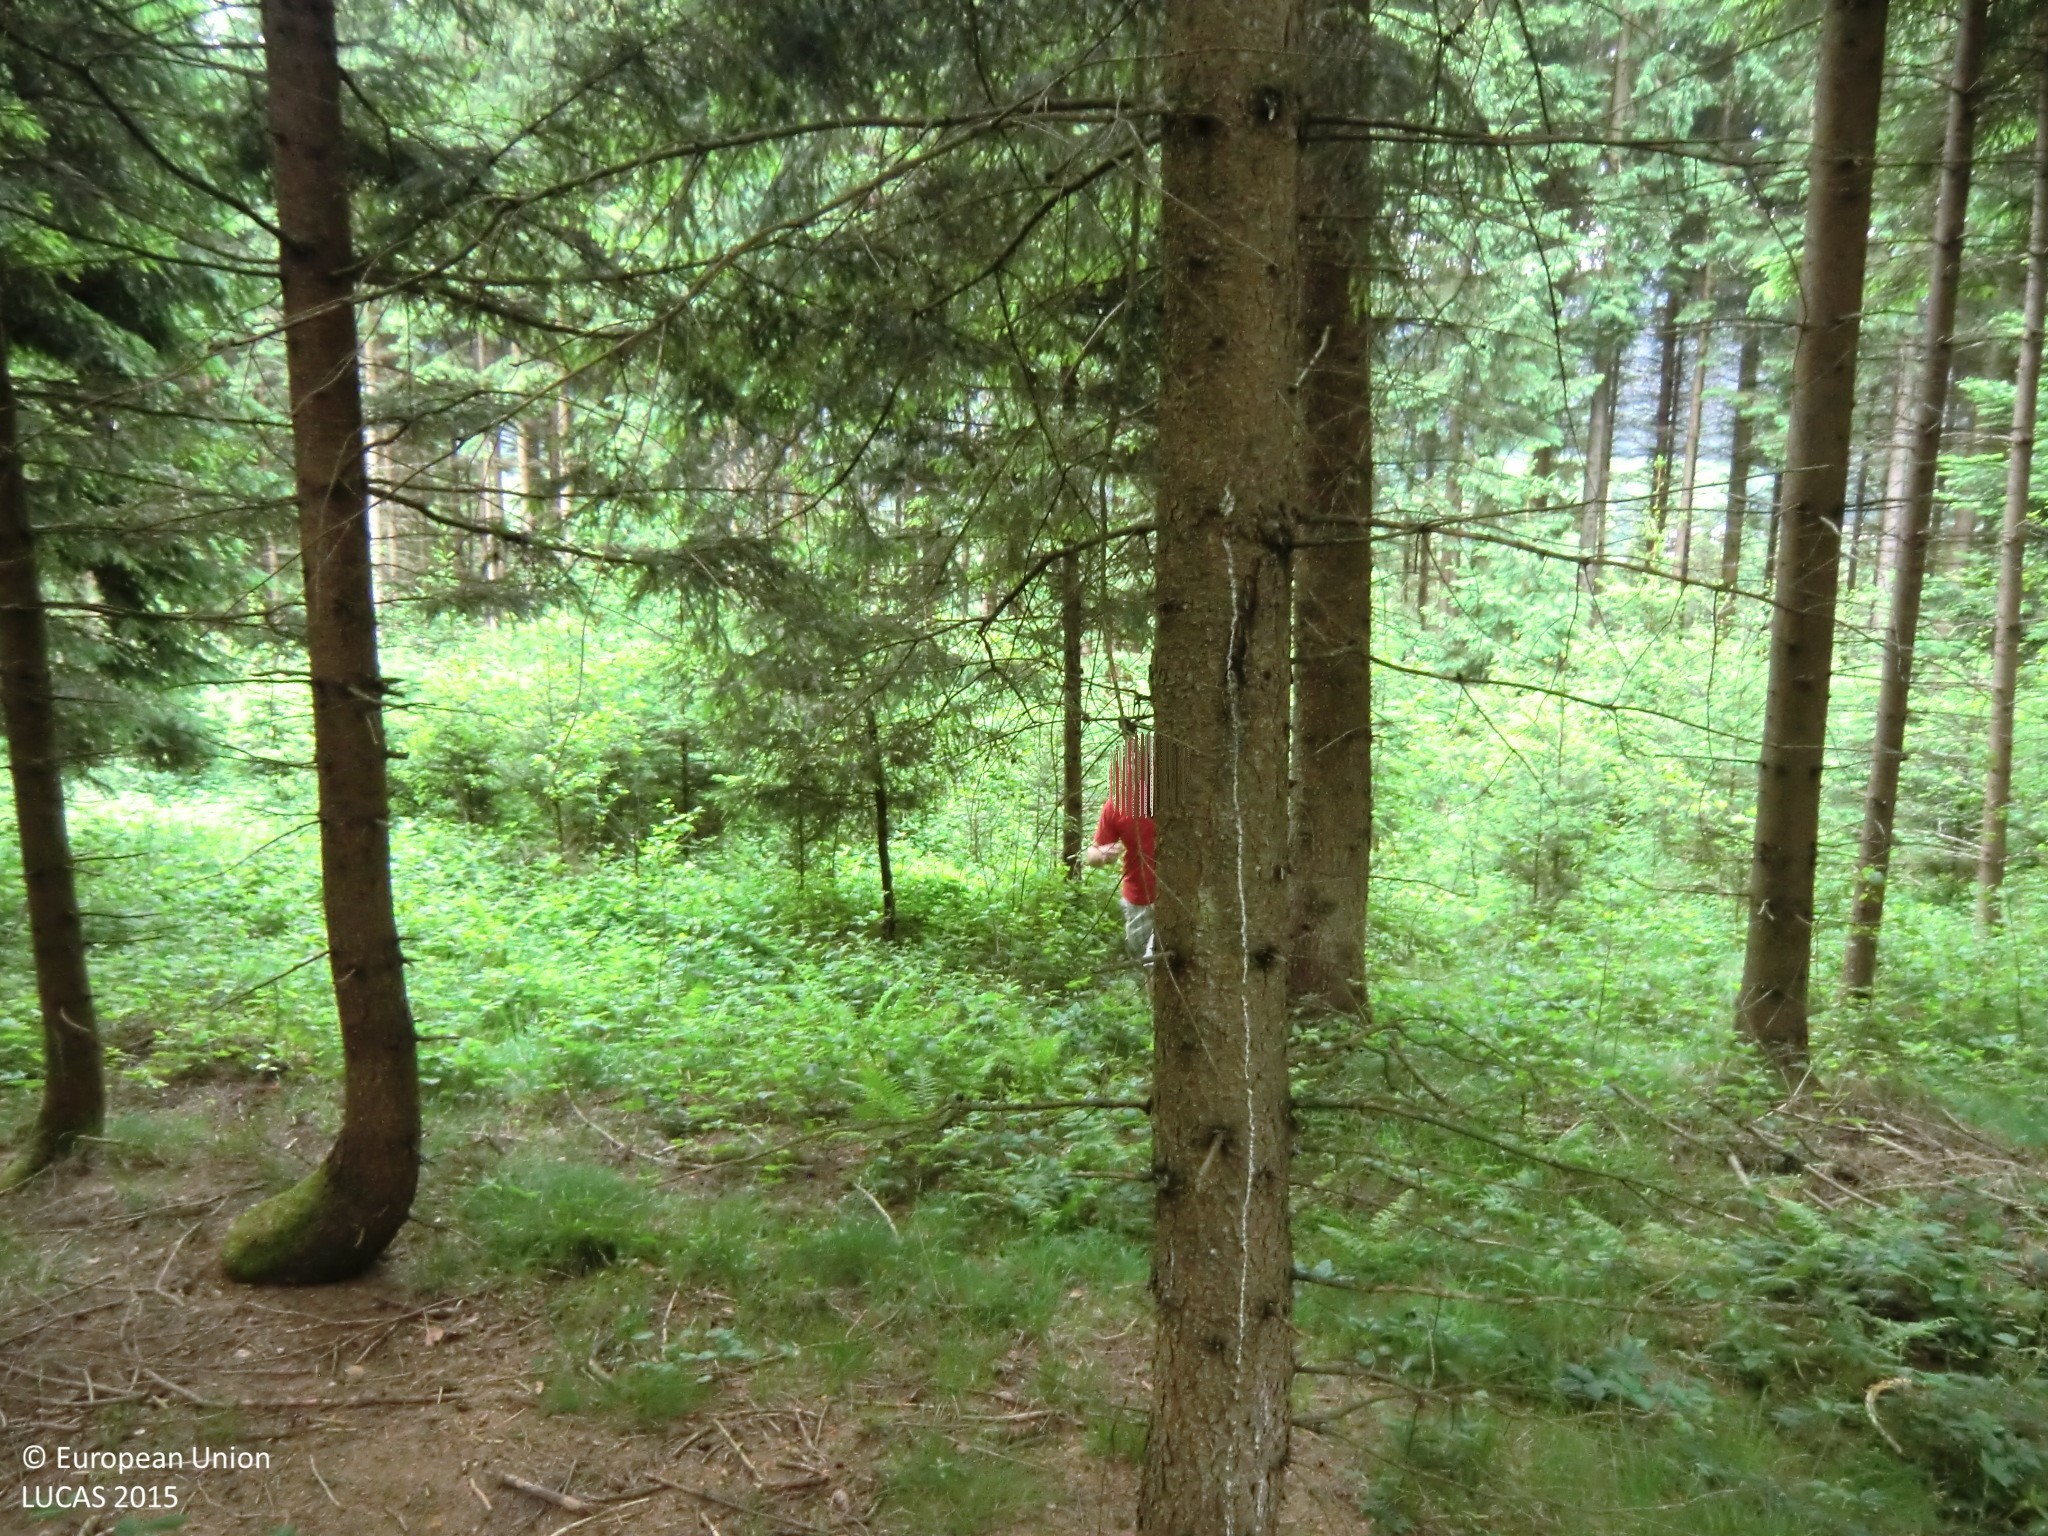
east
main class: Woodland
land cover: Spruce dominated coniferous woodland
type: hemiboreal forest and nemoral coniferous forest and mixed broadleaved-coniferous forest
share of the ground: > 75 %
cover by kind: coniferous forest trees 90 %, unconsolidated bare surface 10 %
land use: Forestry
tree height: > 5 m
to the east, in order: Spruce dominated coniferous woodland; Grassland without tree/shrub cover; Spruce dominated coniferous woodland; Grassland without tree/shrub cover; Broadleaved woodland; Fences; Grassland without tree/shrub cover
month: June
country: AT
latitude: 48.2700
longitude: 15.0537
